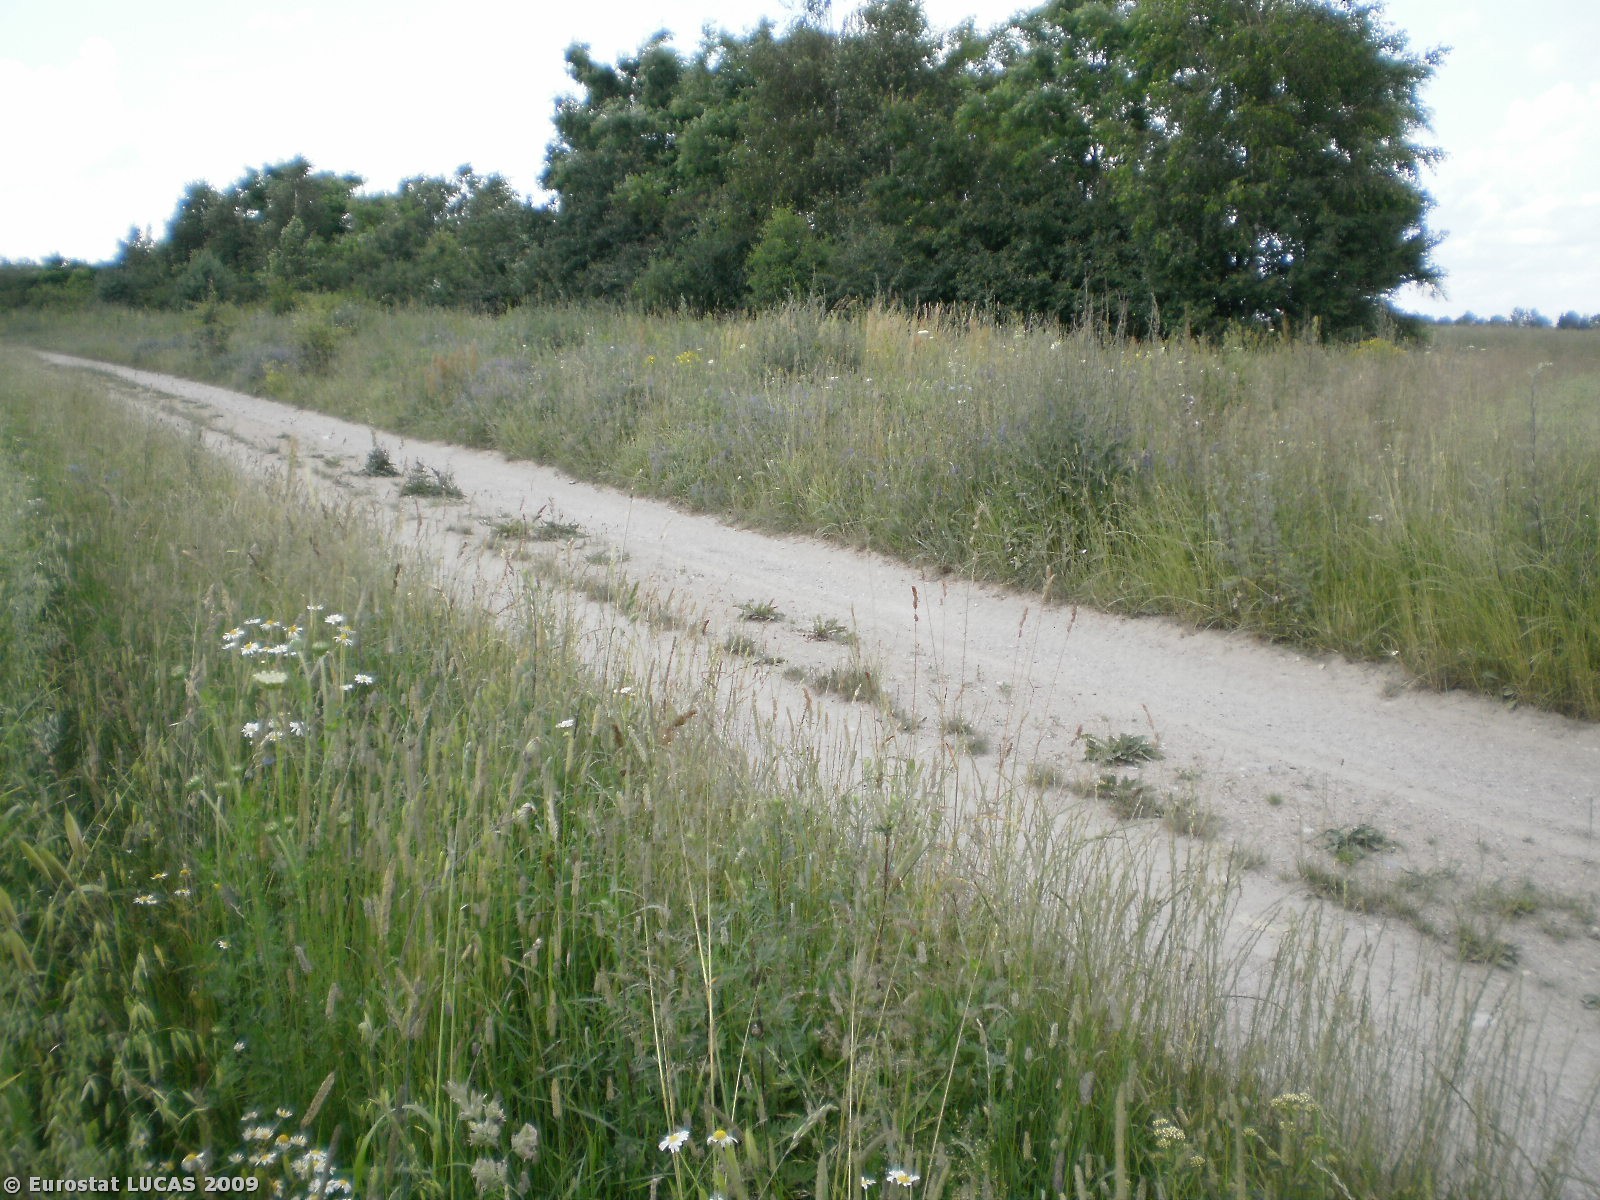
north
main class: Cropland
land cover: Oats
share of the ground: > 75 %
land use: Agriculture (excluding fallow land and kitchen gardens)
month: July
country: PL
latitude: 53.3300
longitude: 20.4424
